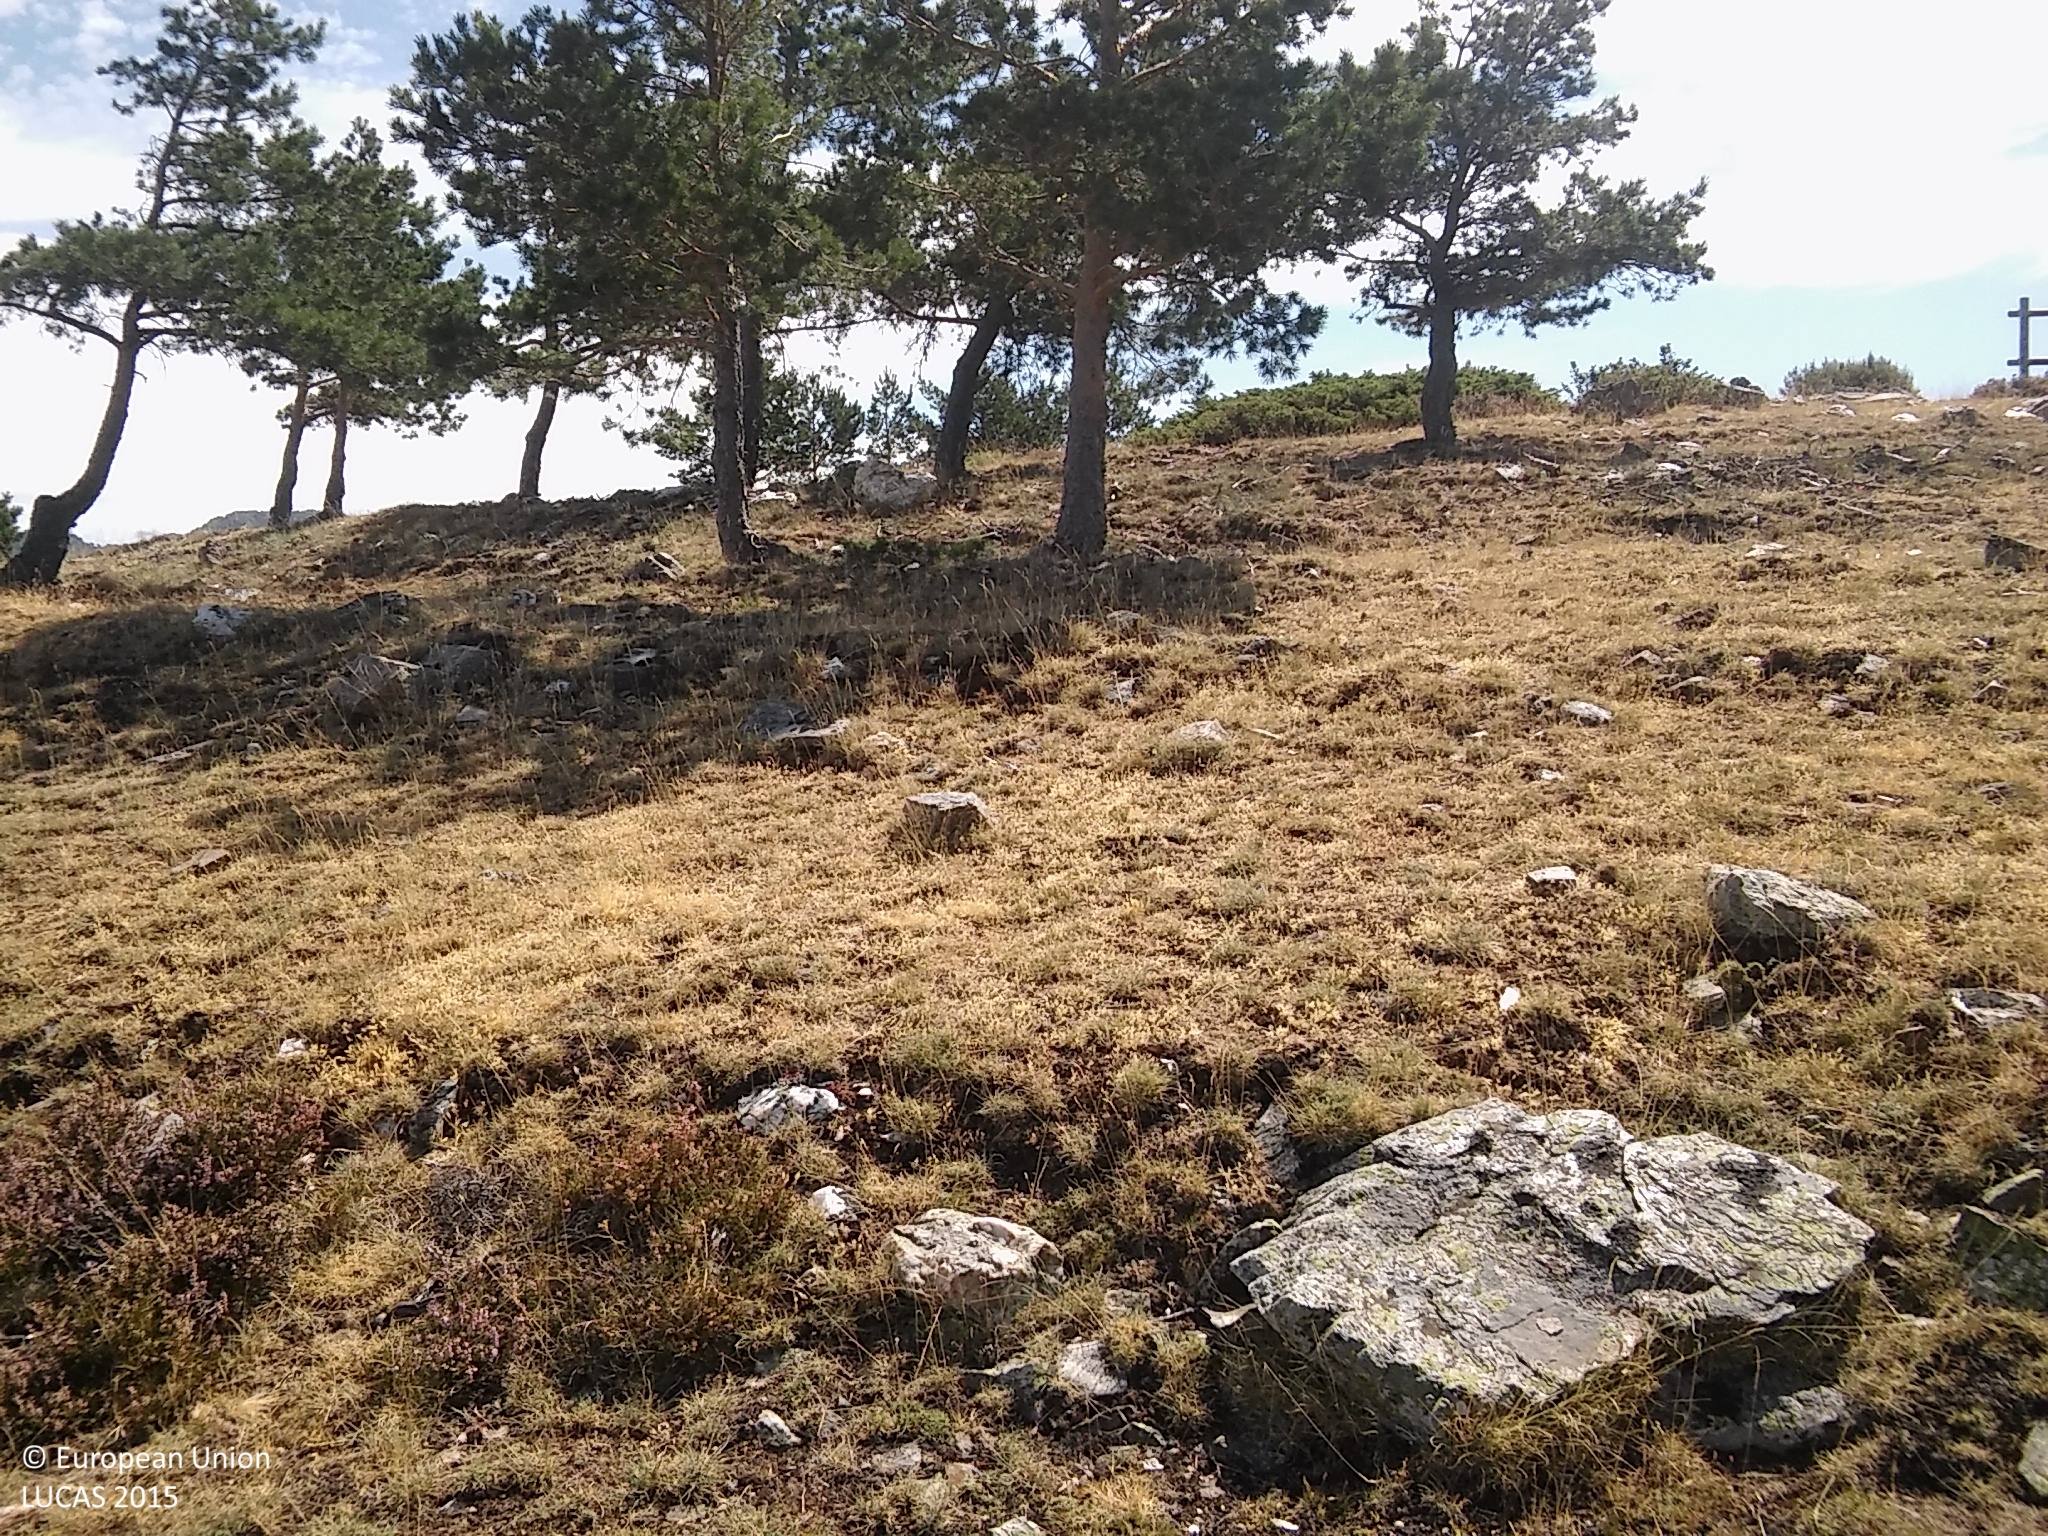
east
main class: Woodland
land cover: Pine dominated coniferous woodland
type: coniferous forest of the mediterranean region
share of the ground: 10 - 25 %
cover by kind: herbaceous plants 85 %, coniferous forest trees 15 %
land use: Forestry
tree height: > 5 m
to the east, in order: Pine dominated coniferous woodland; Shrubland without tree cover; Pine dominated coniferous woodland
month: August
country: ES
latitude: 41.1910
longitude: -3.4089
